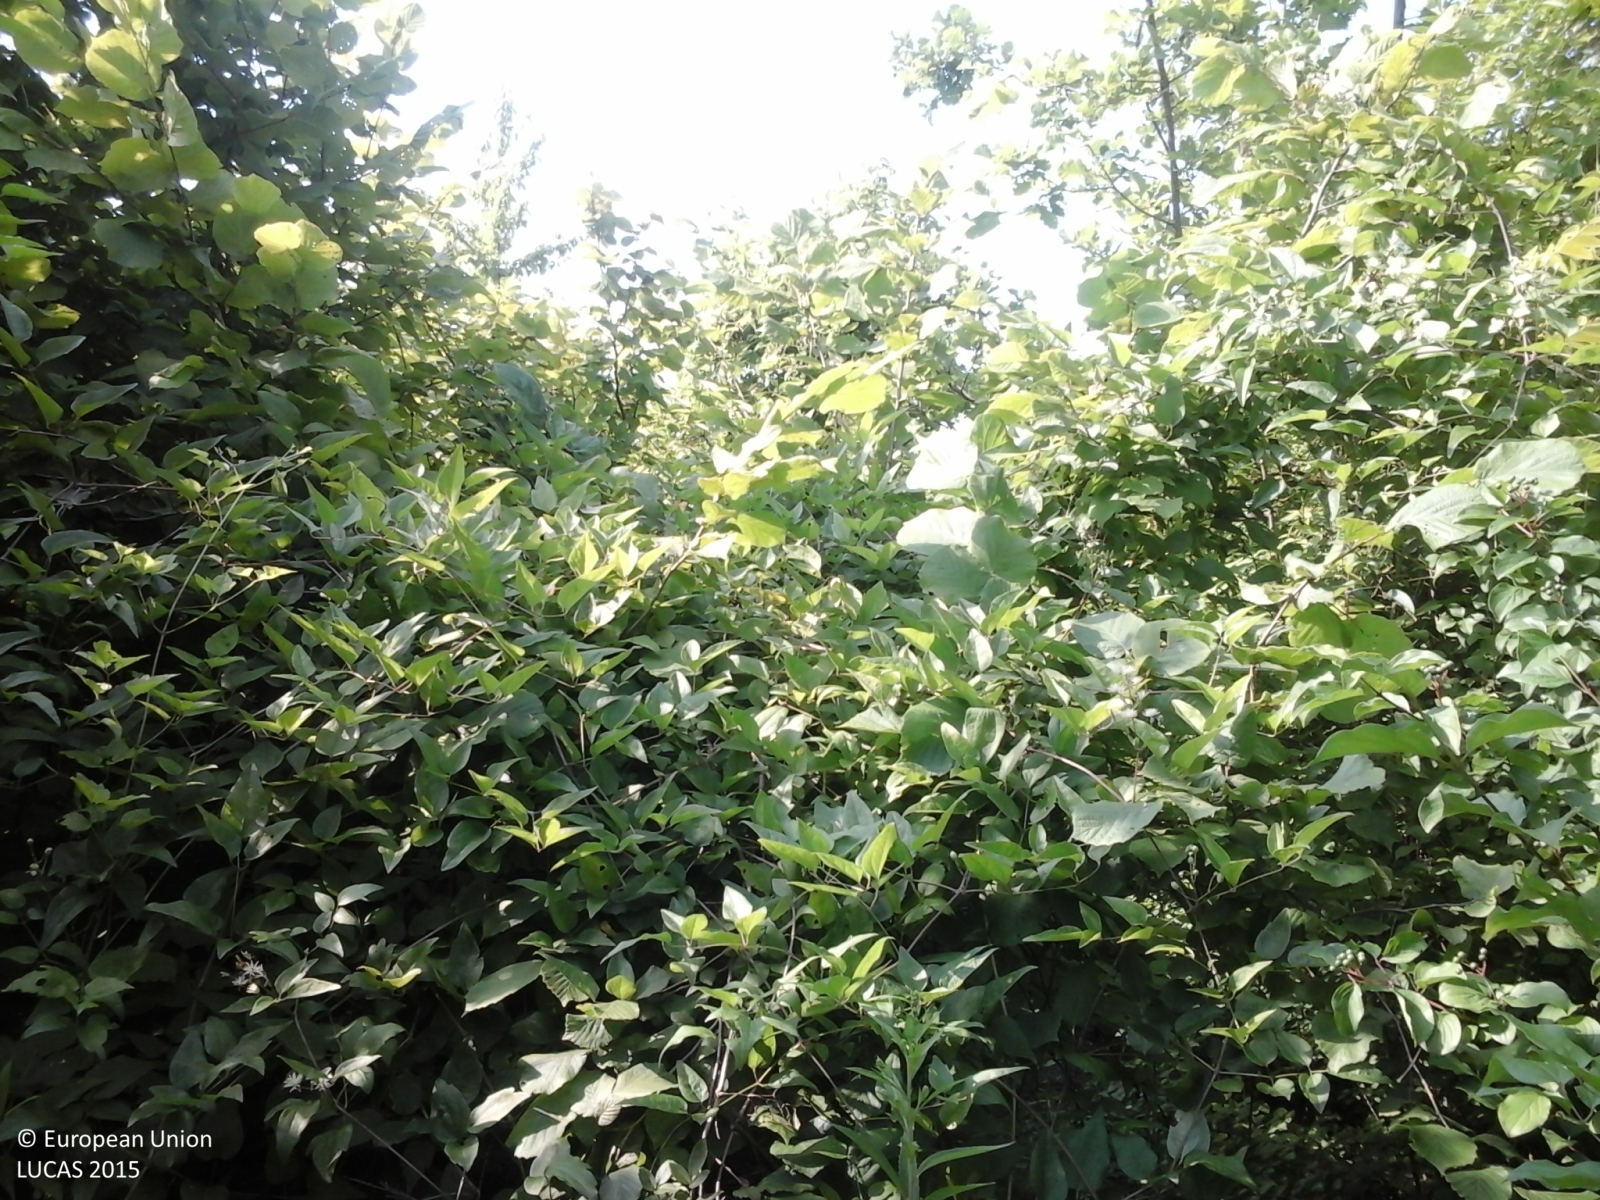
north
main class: Cropland
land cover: Nuts trees
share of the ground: > 75 %
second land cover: Spontaneously vegetated surfaces
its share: > 75 %
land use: Agriculture (excluding fallow land and kitchen gardens)
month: June
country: IT
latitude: 44.9849
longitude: 8.2404
